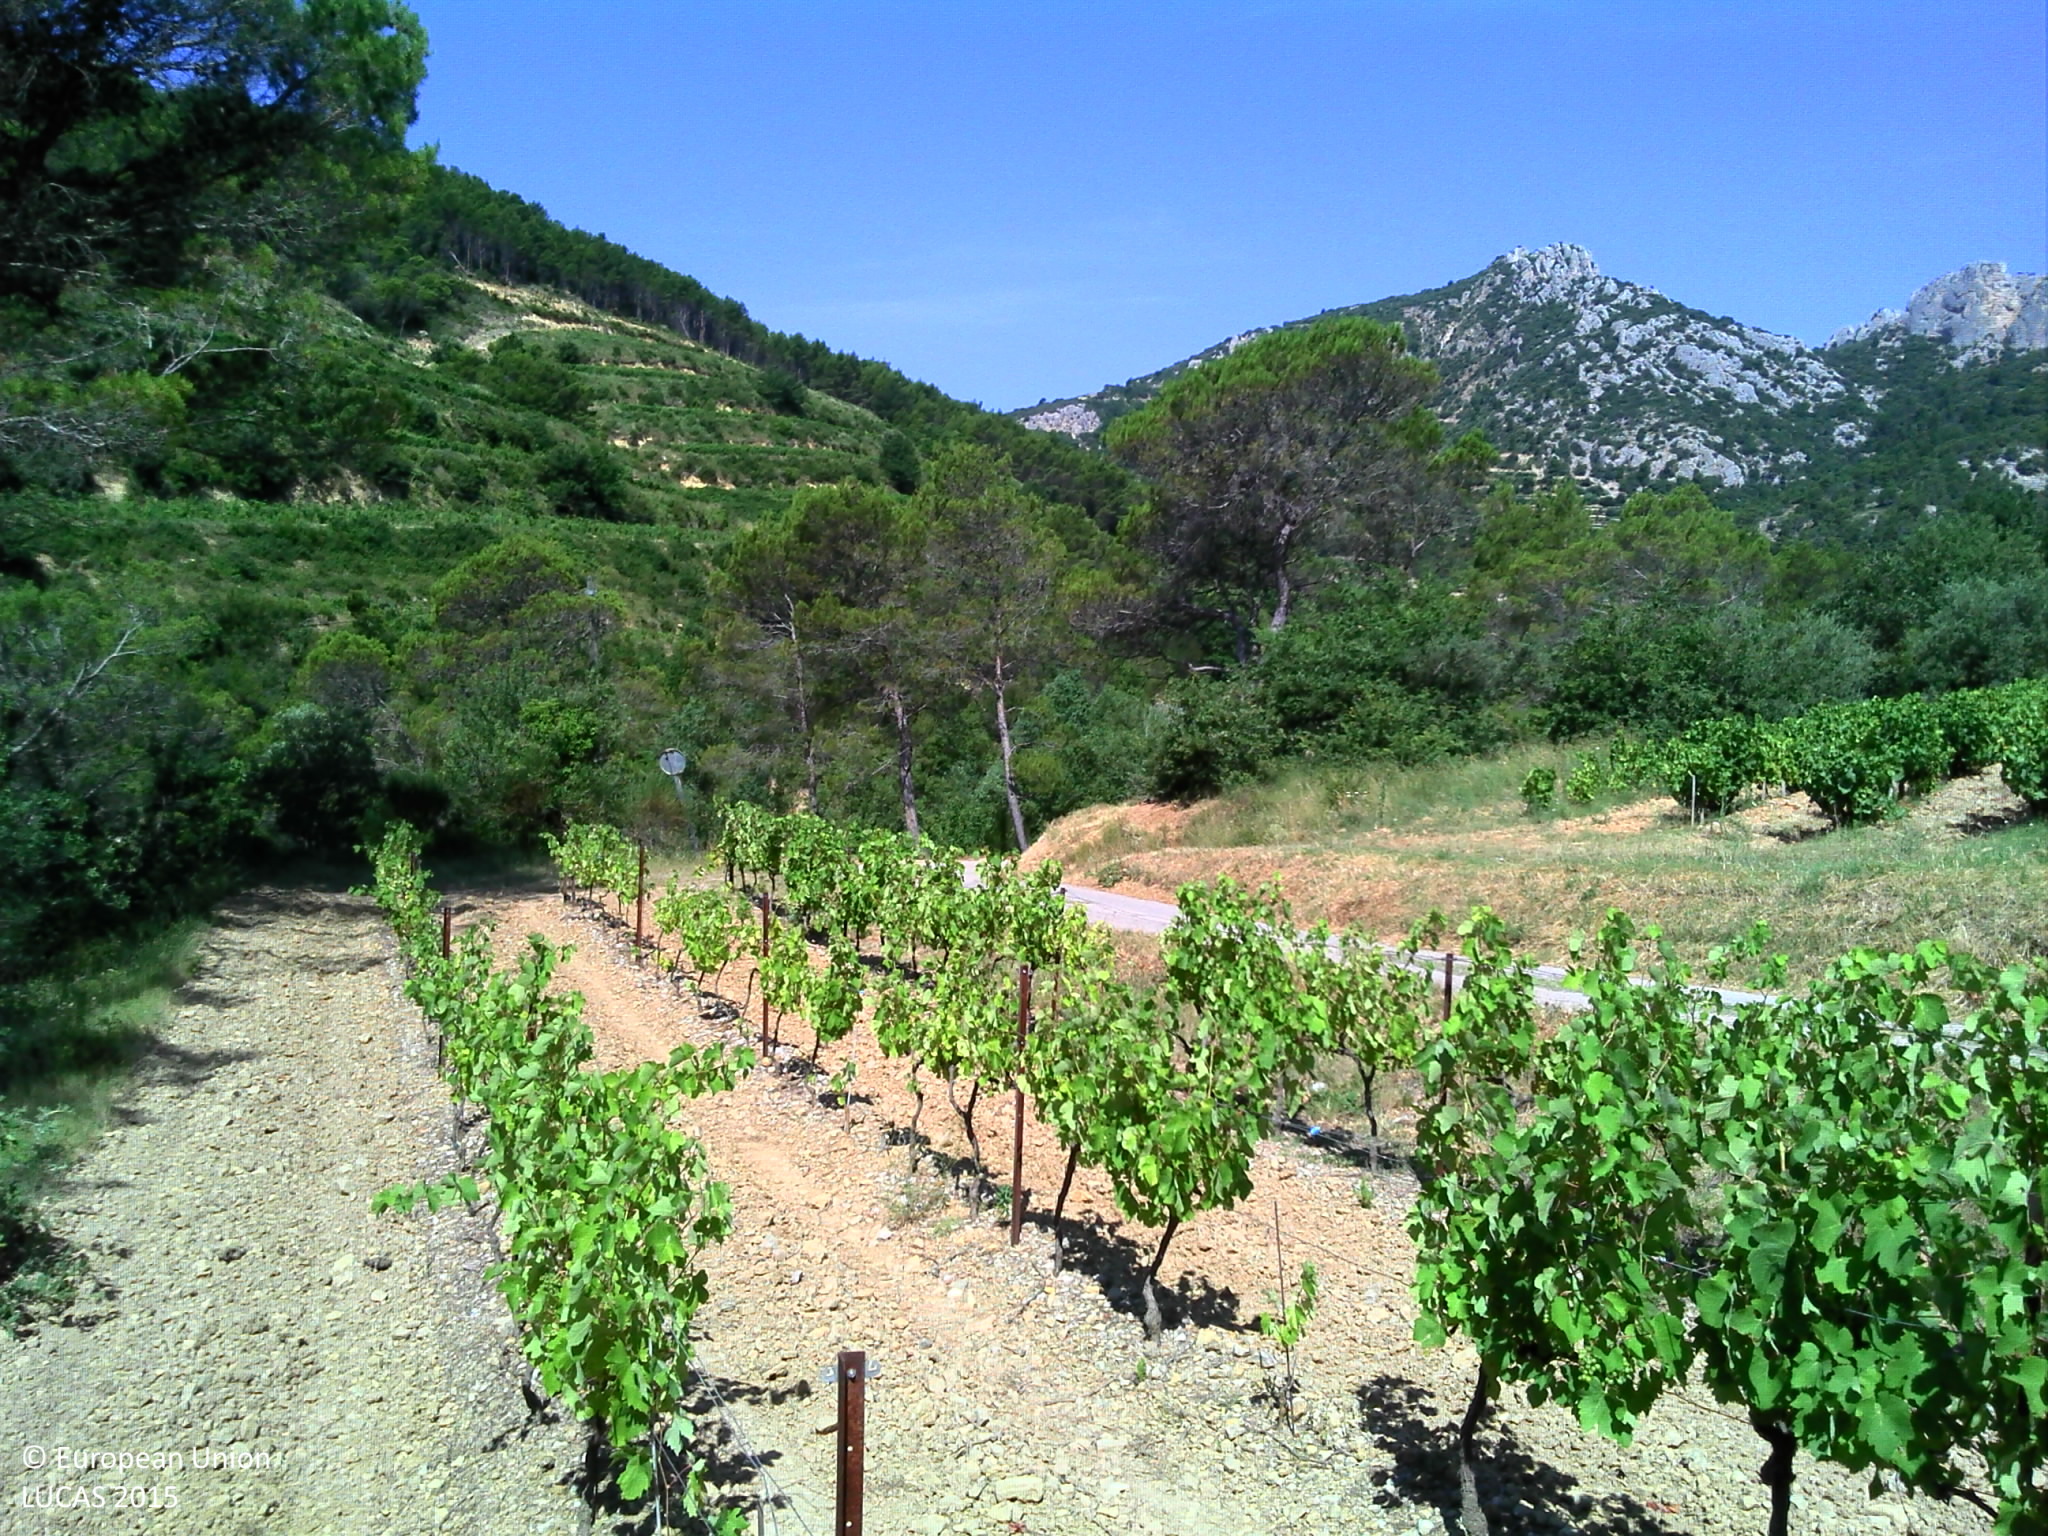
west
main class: Shrubland
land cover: Shrubland with sparse tree cover
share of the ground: > 75 %
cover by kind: shrubs 70 %, herbaceous plants 15 %, unconsolidated bare surface 10 %, coniferous forest trees 5 %
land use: Semi-natural and natural areas not in use
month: July
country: FR
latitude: 44.1419
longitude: 5.0452
